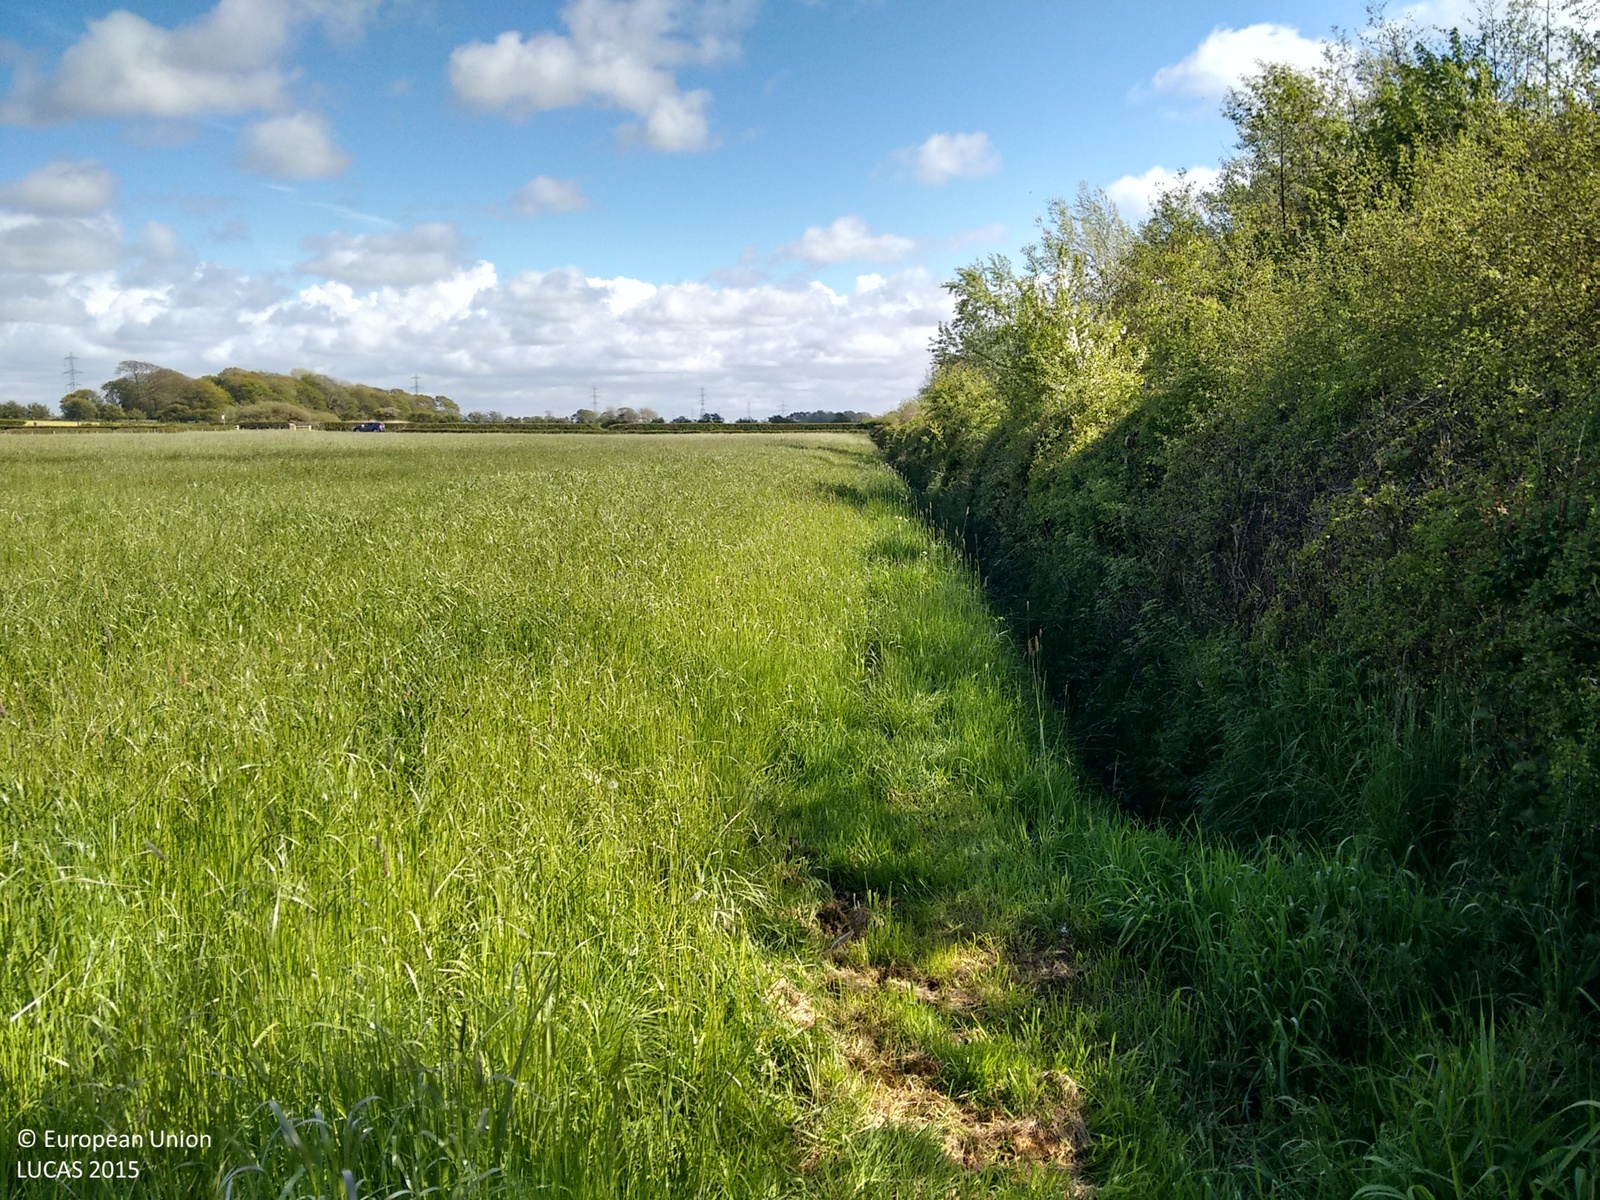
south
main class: Grassland
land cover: Grassland without tree/shrub cover
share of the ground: > 75 %
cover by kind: herbaceous plants 100 %
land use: Construction
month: May
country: GB
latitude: 53.8542
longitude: -2.9183
